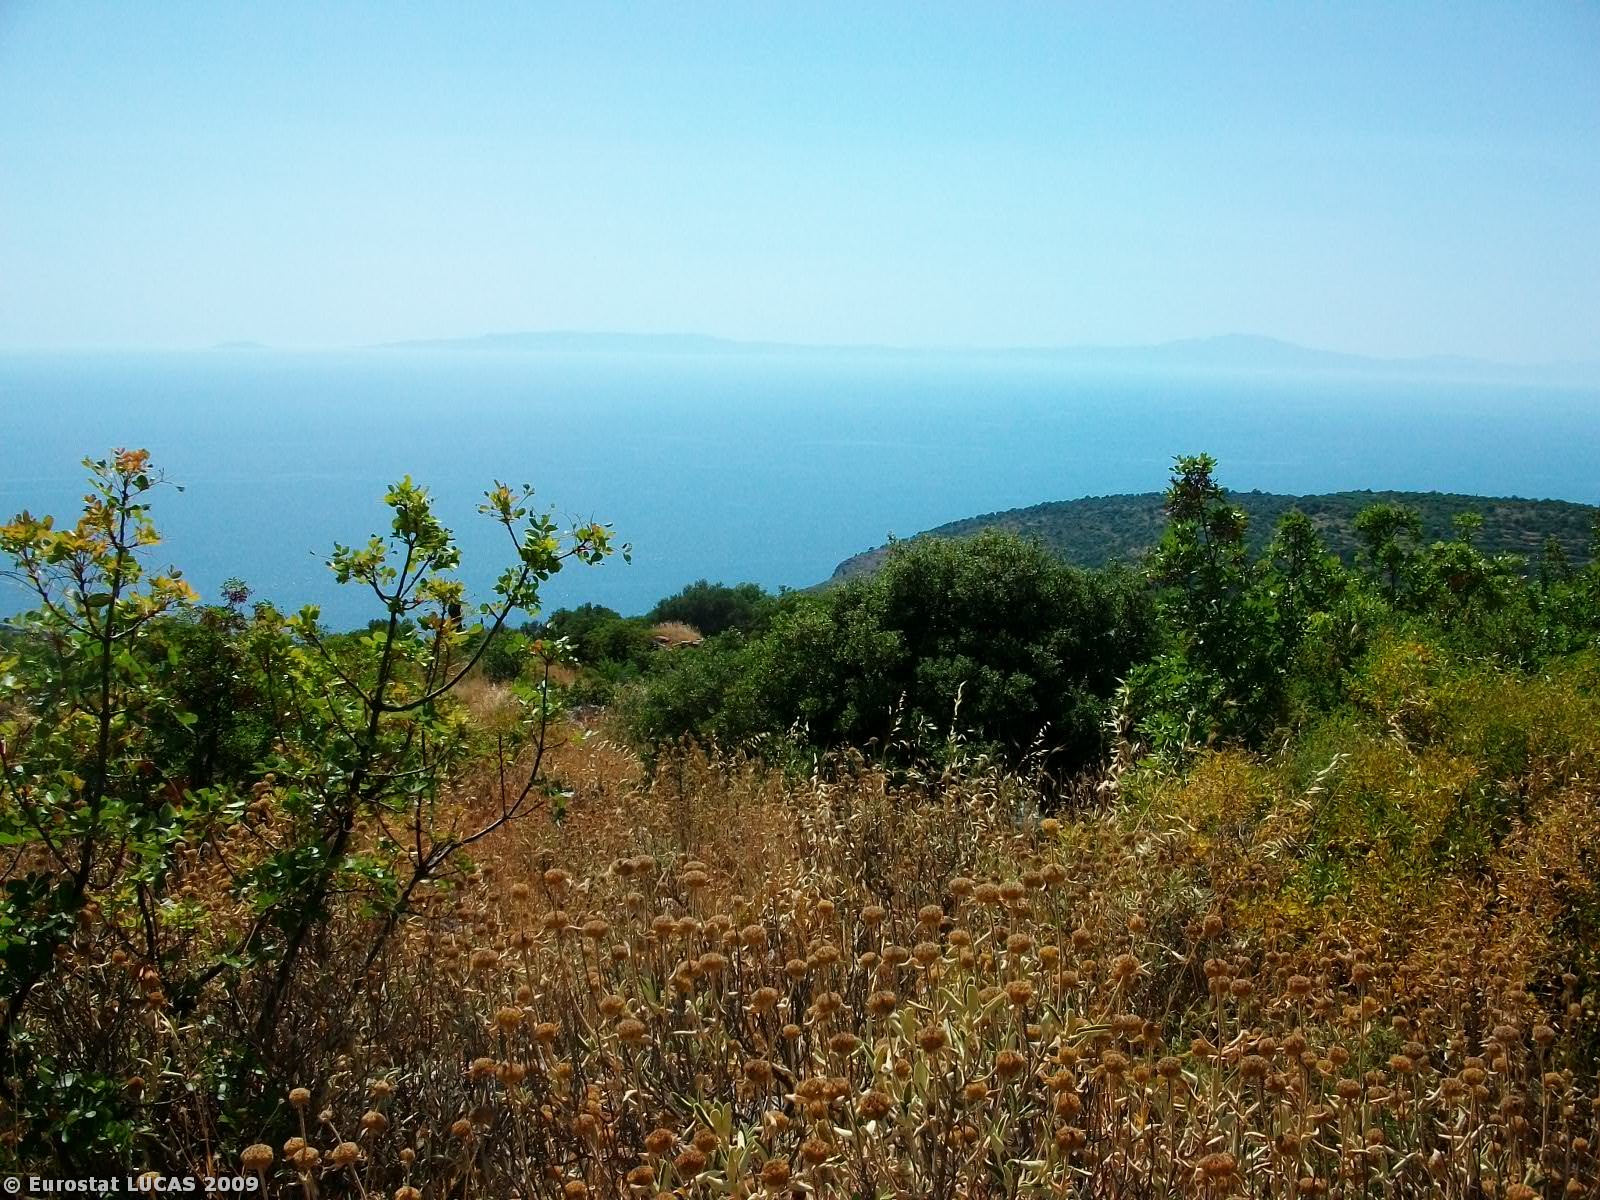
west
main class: Shrubland
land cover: Shrubland with sparse tree cover
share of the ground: > 75 %
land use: Unused
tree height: < 5 m
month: June
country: GR
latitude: 36.7974
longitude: 22.3129
